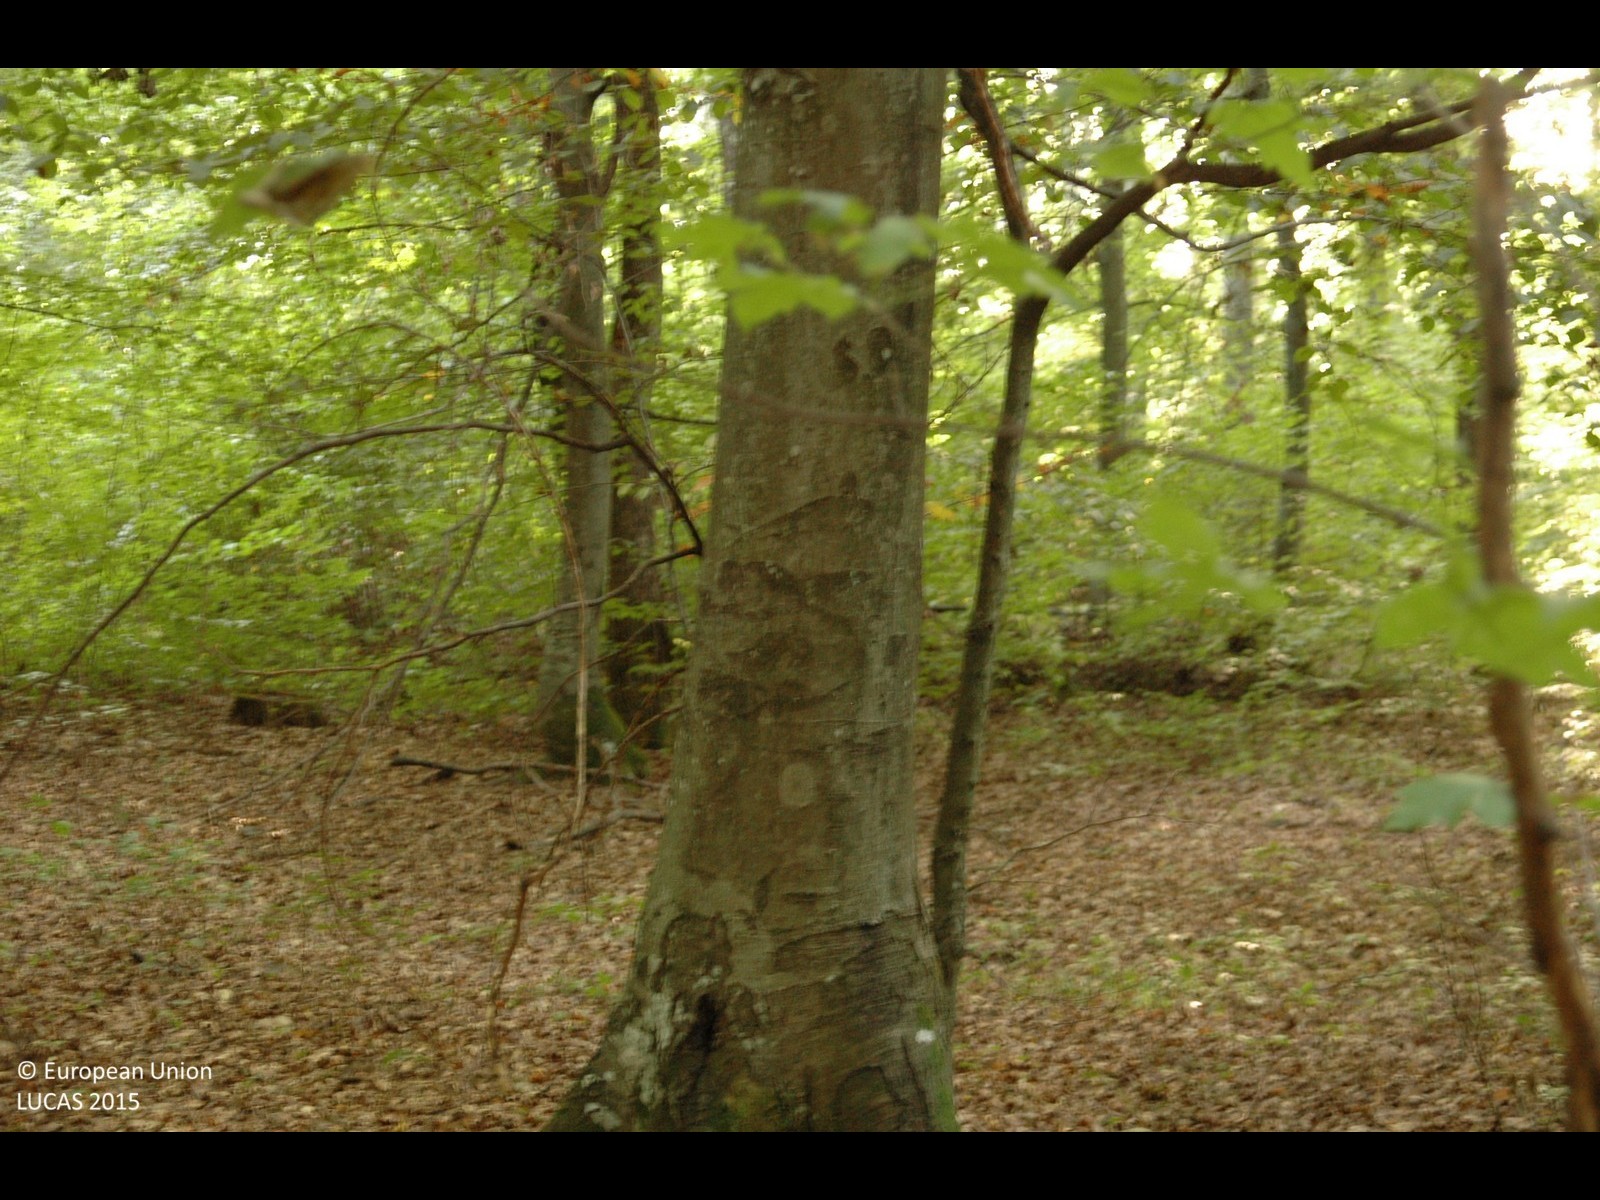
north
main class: Woodland
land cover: Broadleaved woodland
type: beech forest
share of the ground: > 75 %
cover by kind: broadleaved forest trees 100 %
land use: Forestry
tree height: > 5 m
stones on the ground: < 10 %
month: September
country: HR
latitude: 45.6638
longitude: 15.9142
